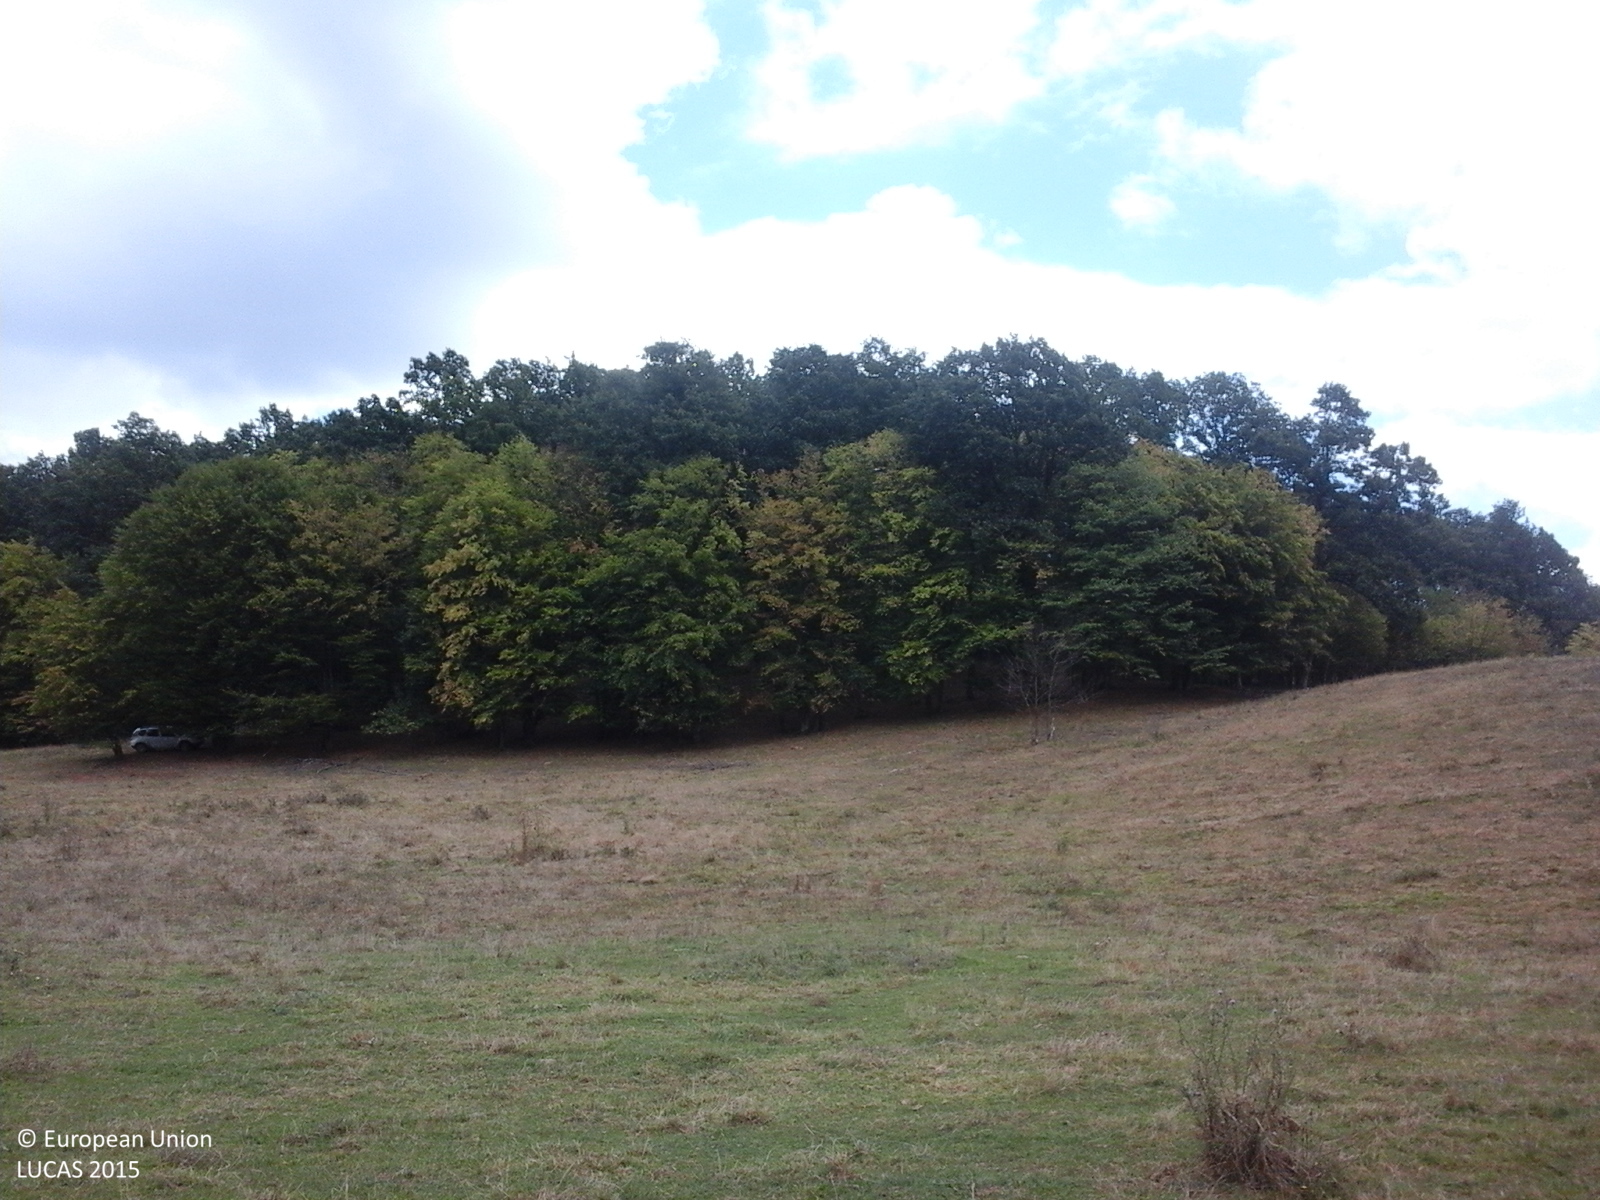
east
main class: Grassland
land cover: Grassland without tree/shrub cover
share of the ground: > 75 %
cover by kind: herbaceous plants 100 %
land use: Agriculture (excluding fallow land and kitchen gardens)
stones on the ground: < 10 %
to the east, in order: Grassland without tree/shrub cover; Broadleaved woodland; Tracks; Broadleaved woodland
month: September
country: RO
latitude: 47.3301
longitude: 23.2346
